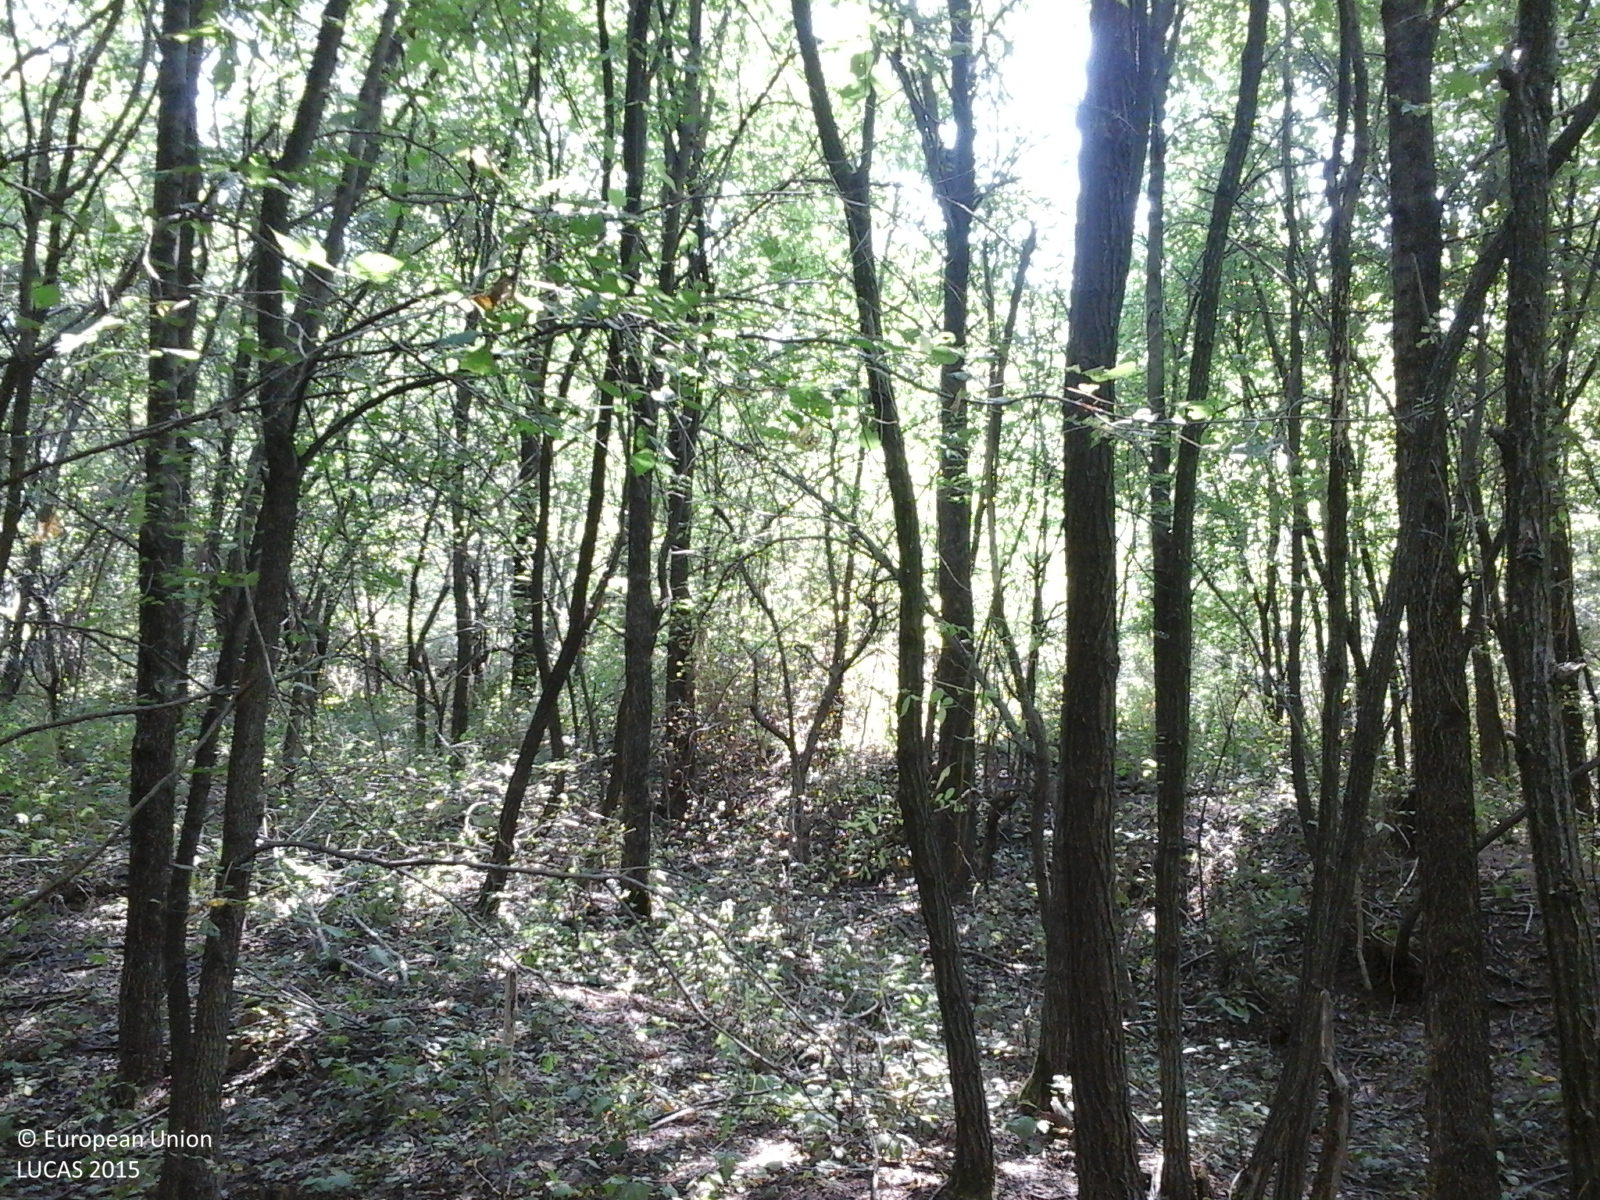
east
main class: Woodland
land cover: Broadleaved woodland
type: non-riverine alder, birch or aspen forest
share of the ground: > 75 %
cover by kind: broadleaved forest trees 100 %
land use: Forestry
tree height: > 5 m
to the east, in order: Broadleaved woodland; Artificial constructions in urban areas; Oats; Tracks; Maize
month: July
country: RO
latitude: 44.6811
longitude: 24.6214
